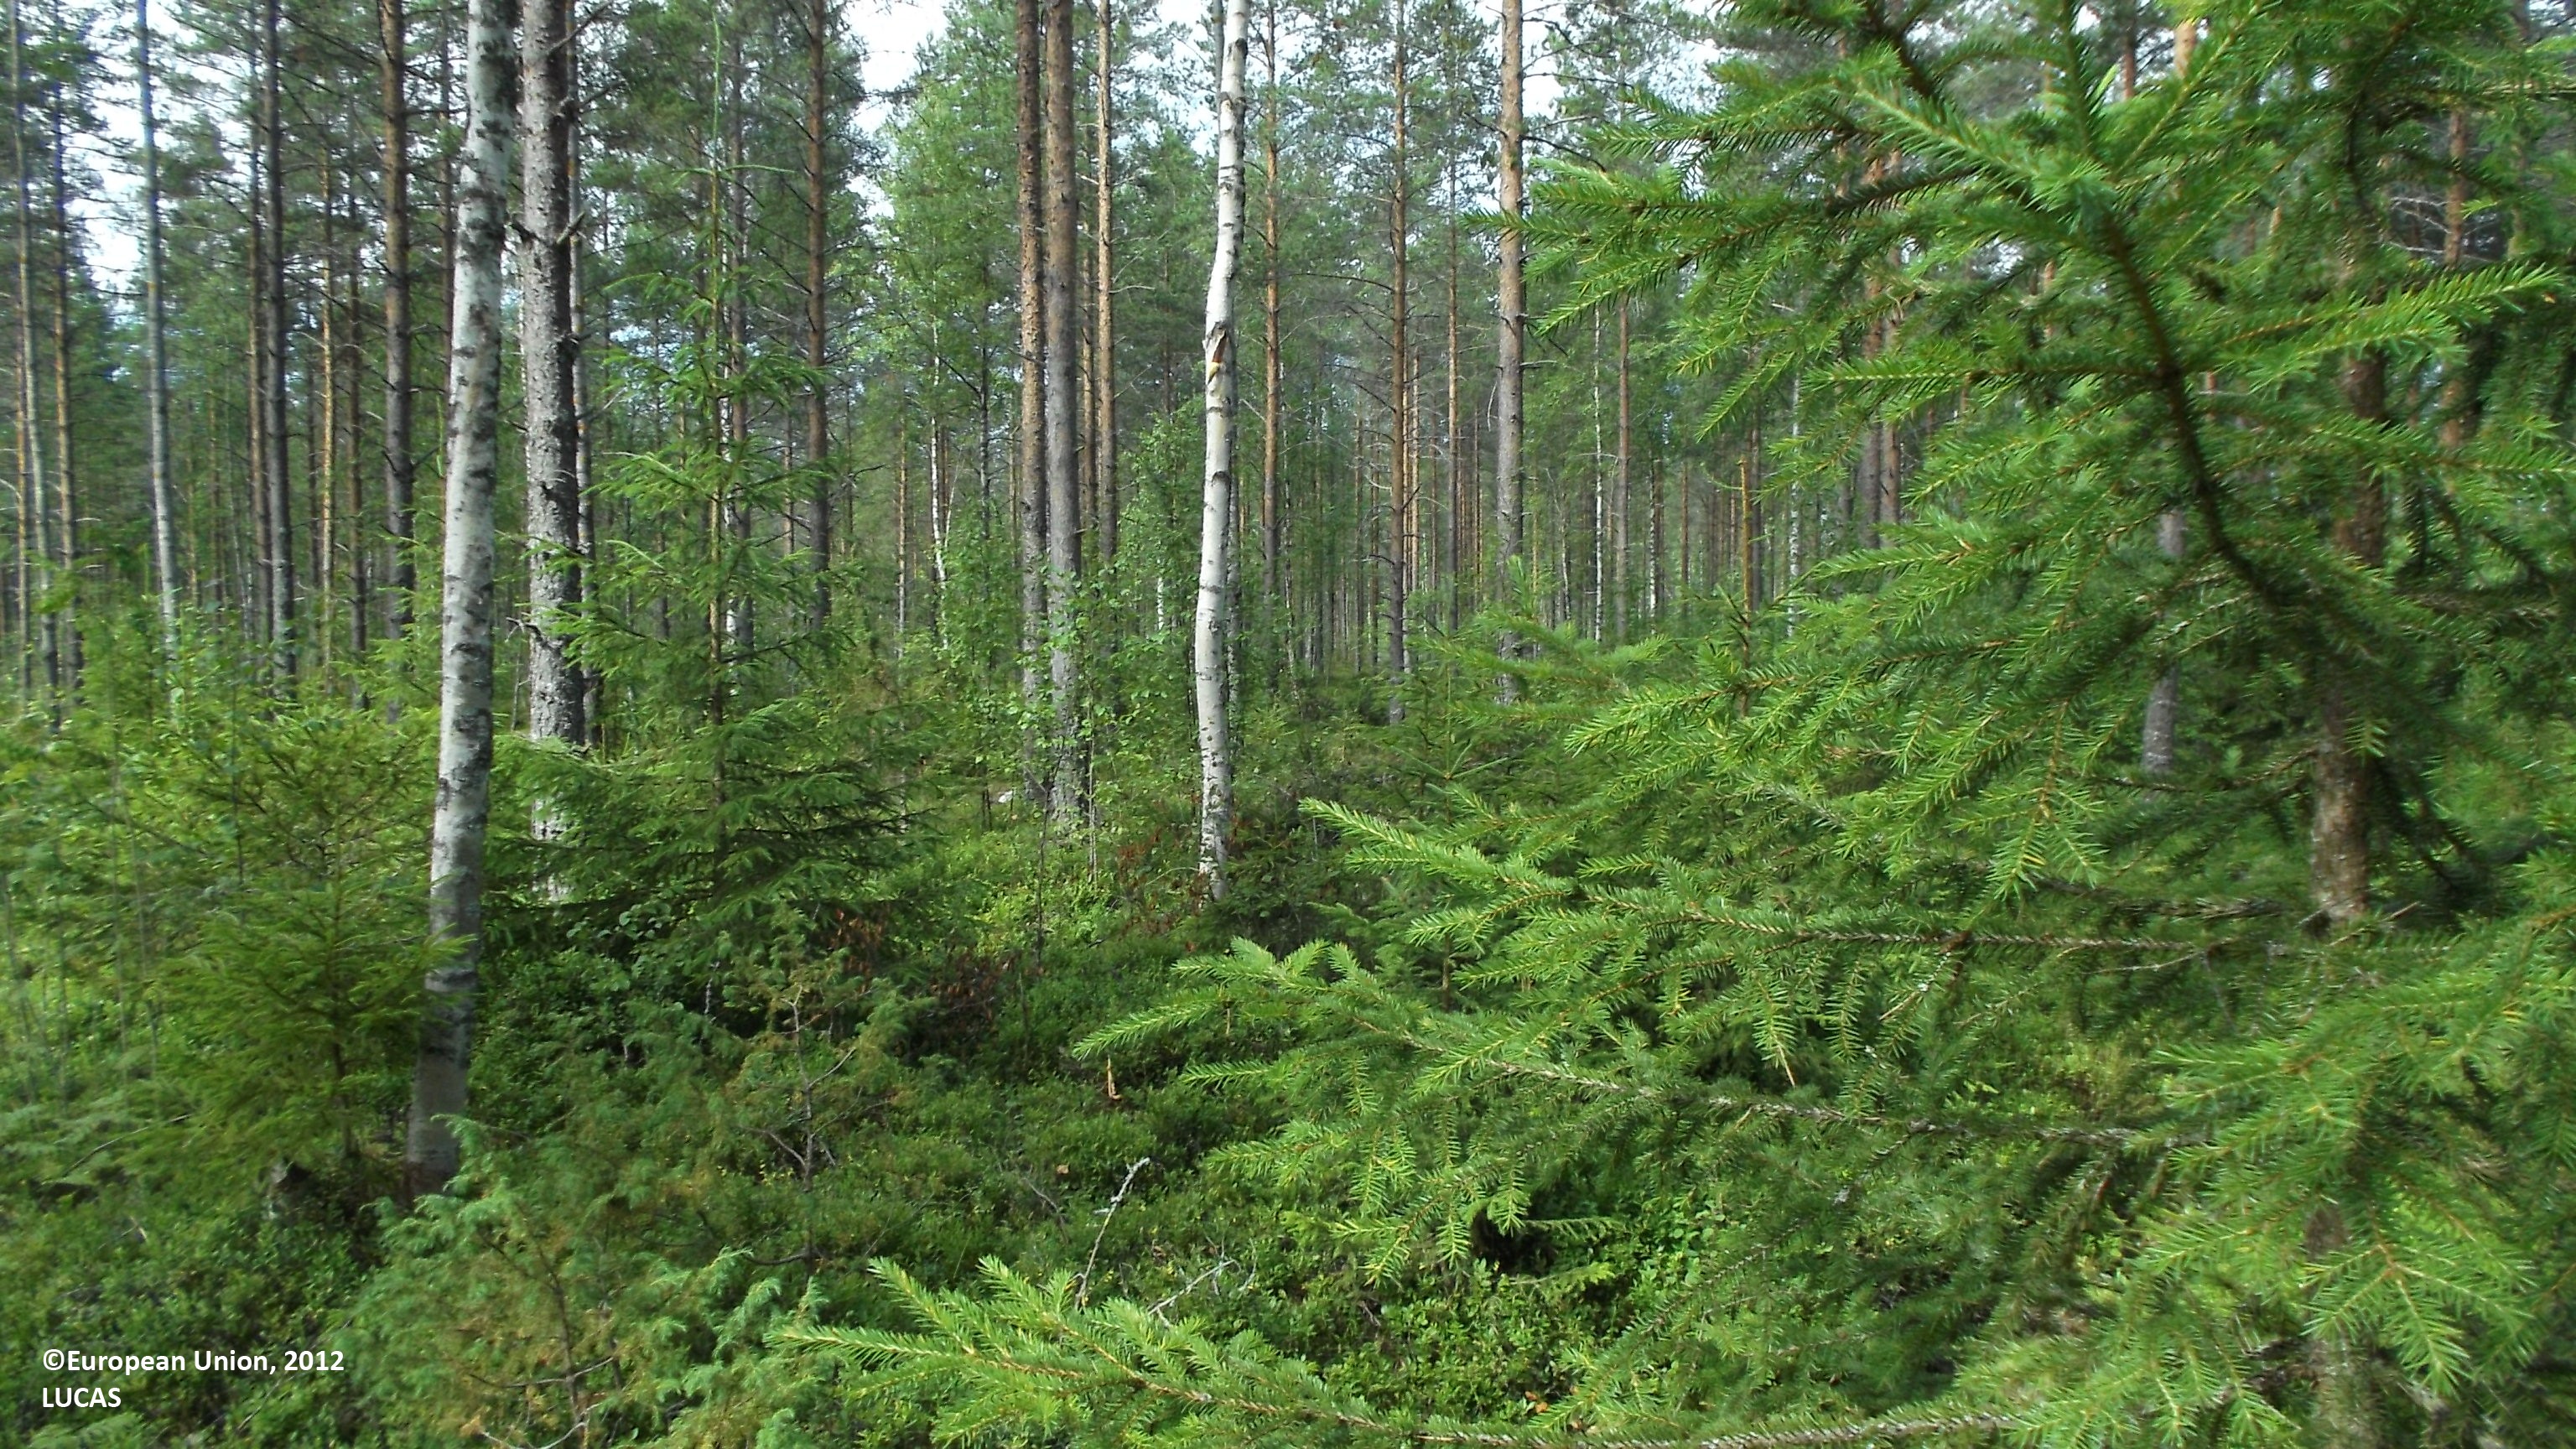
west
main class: Woodland
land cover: Other mixed woodland
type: boreal forest
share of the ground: 25 - 50 %
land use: Forestry
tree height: > 5 m
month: July
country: FI
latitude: 63.4880
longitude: 23.6993
